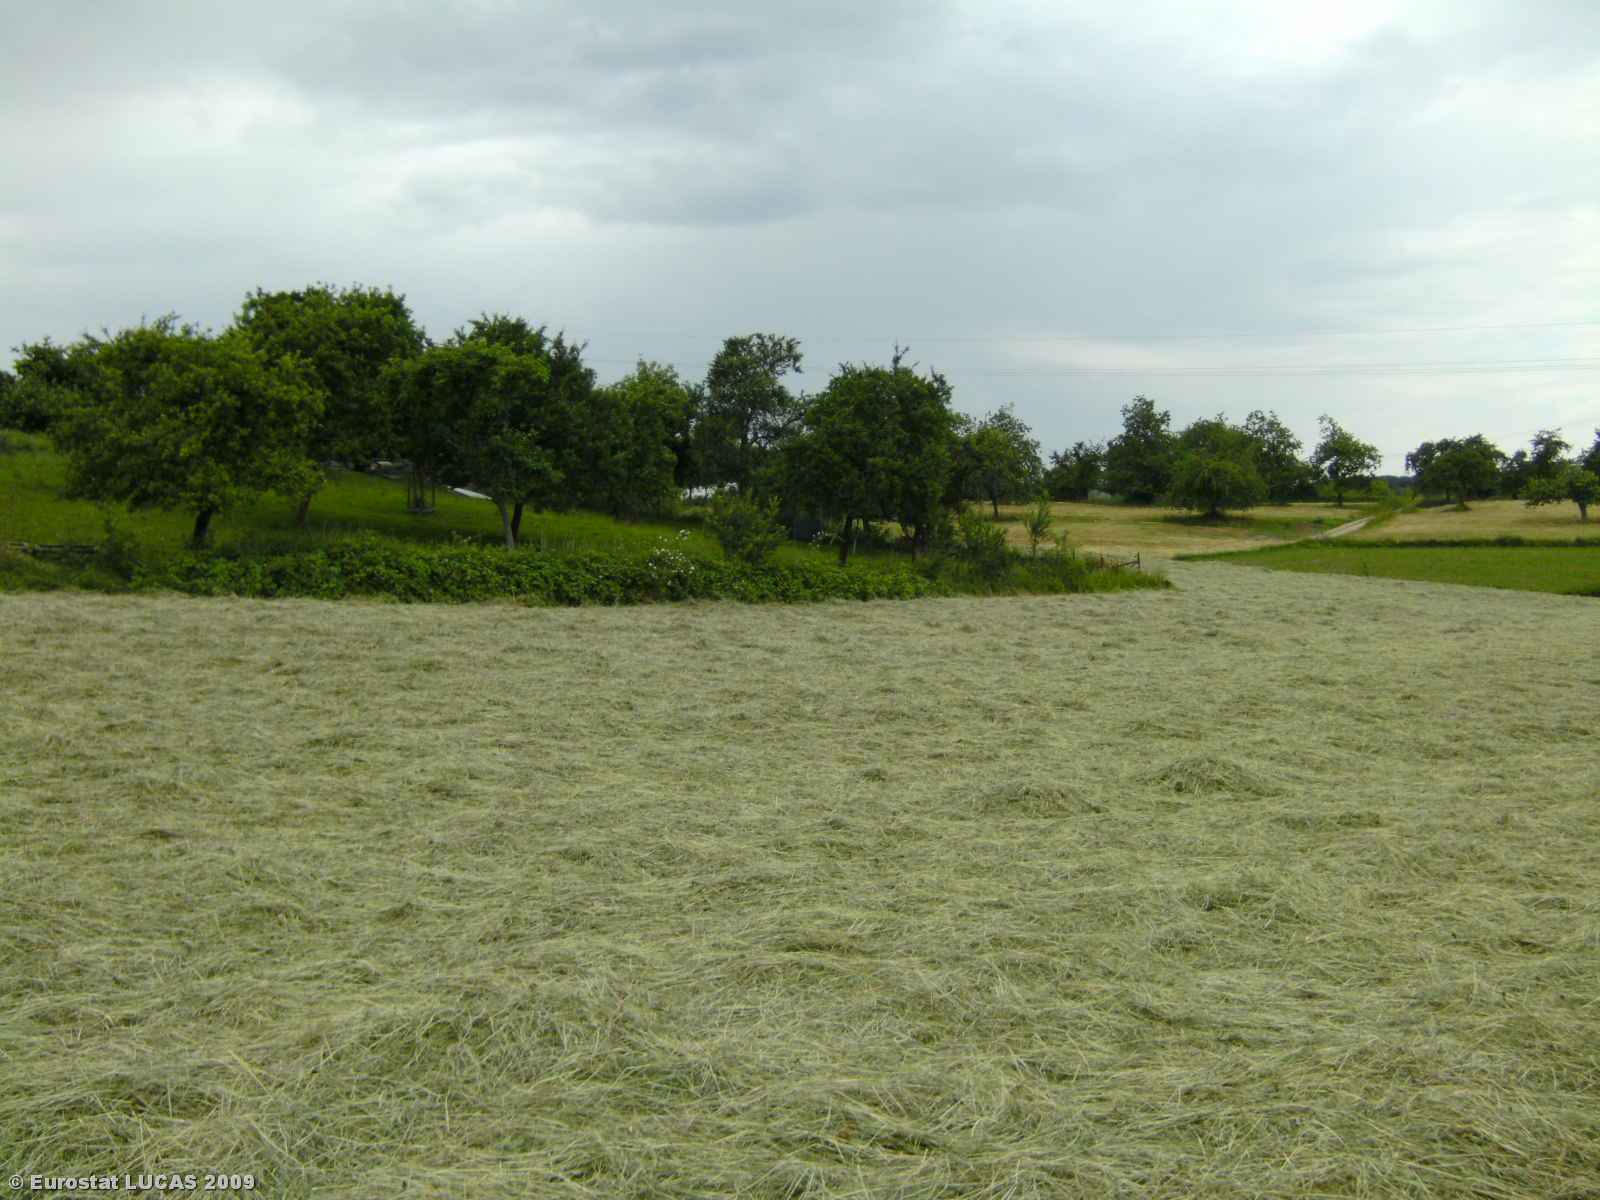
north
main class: Grassland
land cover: Grassland without tree/shrub cover
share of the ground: > 75 %
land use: Agriculture (excluding fallow land and kitchen gardens)
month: June
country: LU
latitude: 49.5655
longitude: 6.2803
